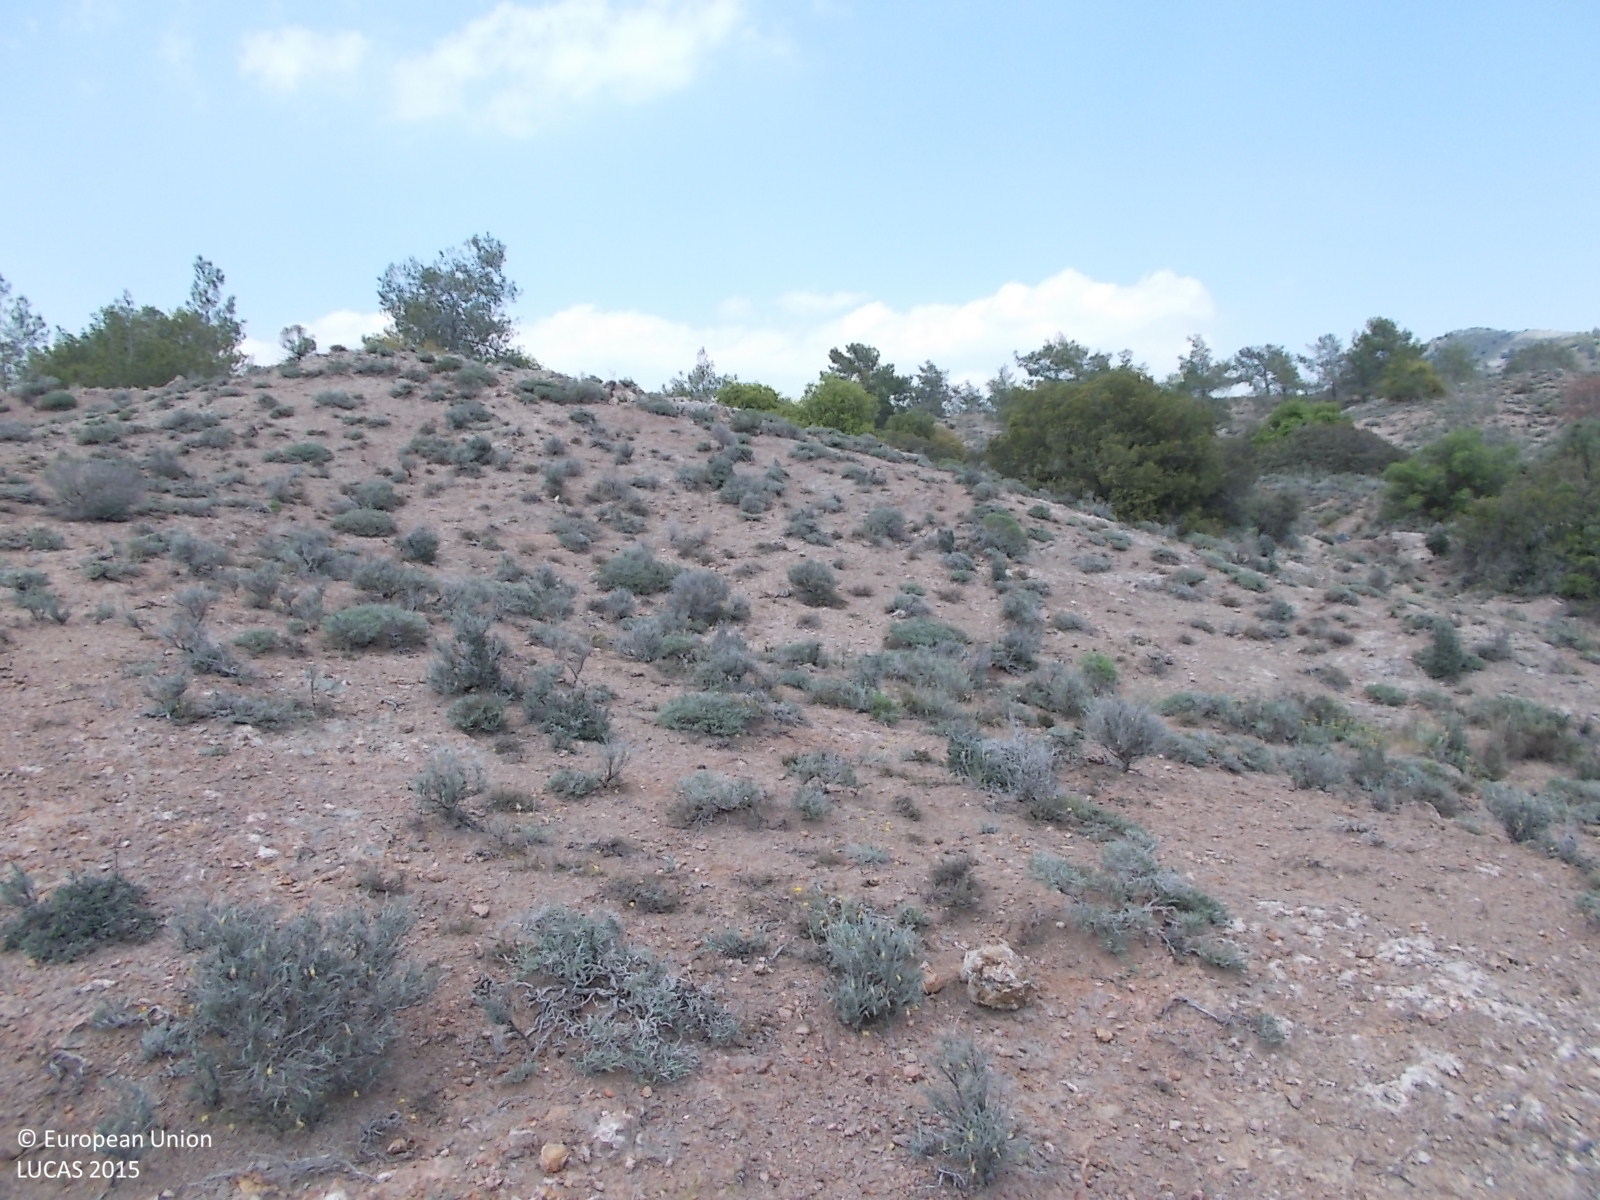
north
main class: Shrubland
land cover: Shrubland without tree cover
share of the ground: 25 - 50 %
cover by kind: unconsolidated bare surface 50 %, shrubs 45 %, consolidated bare surface 5 %
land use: Semi-natural and natural areas not in use
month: April
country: CY
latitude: 34.9217
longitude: 33.4502
